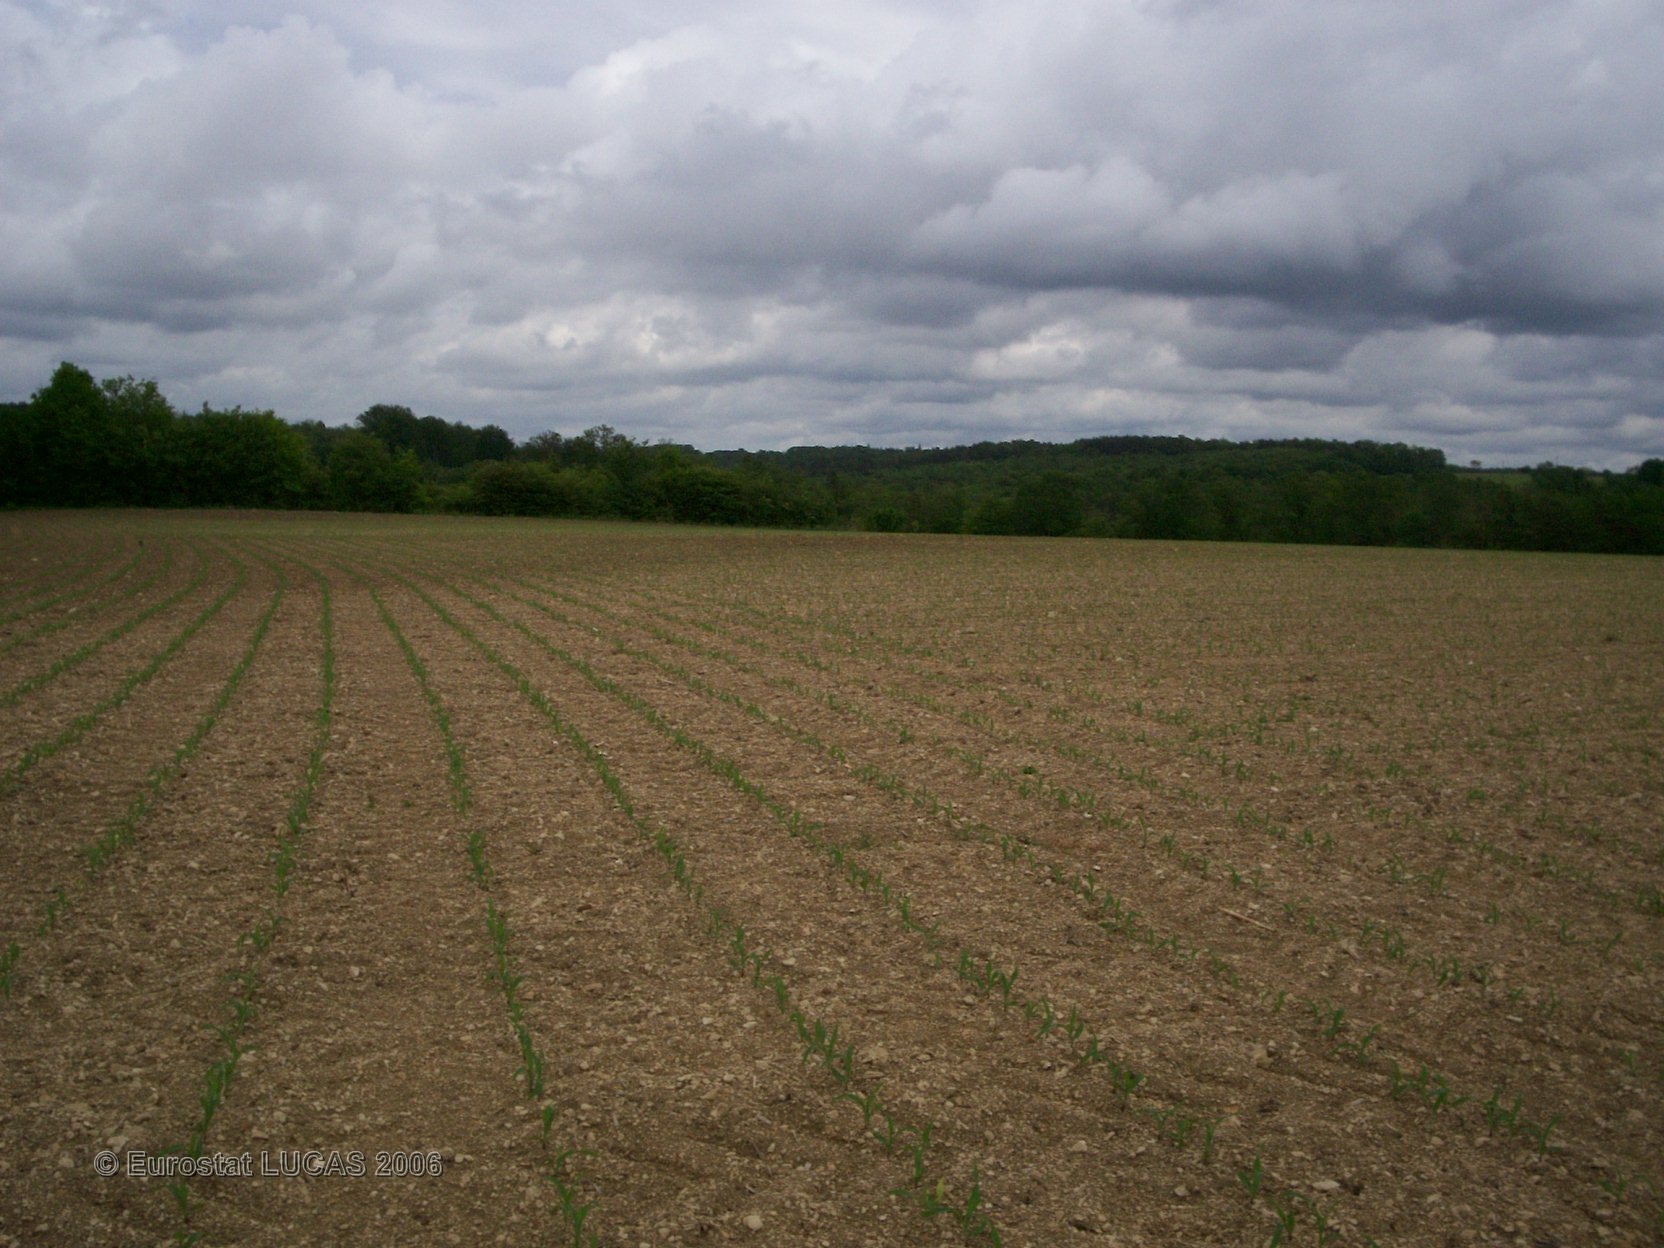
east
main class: Cropland
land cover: Maize
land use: Agriculture (excluding fallow land and kitchen gardens)
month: May
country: FR
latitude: 45.2986
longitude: 0.5645
